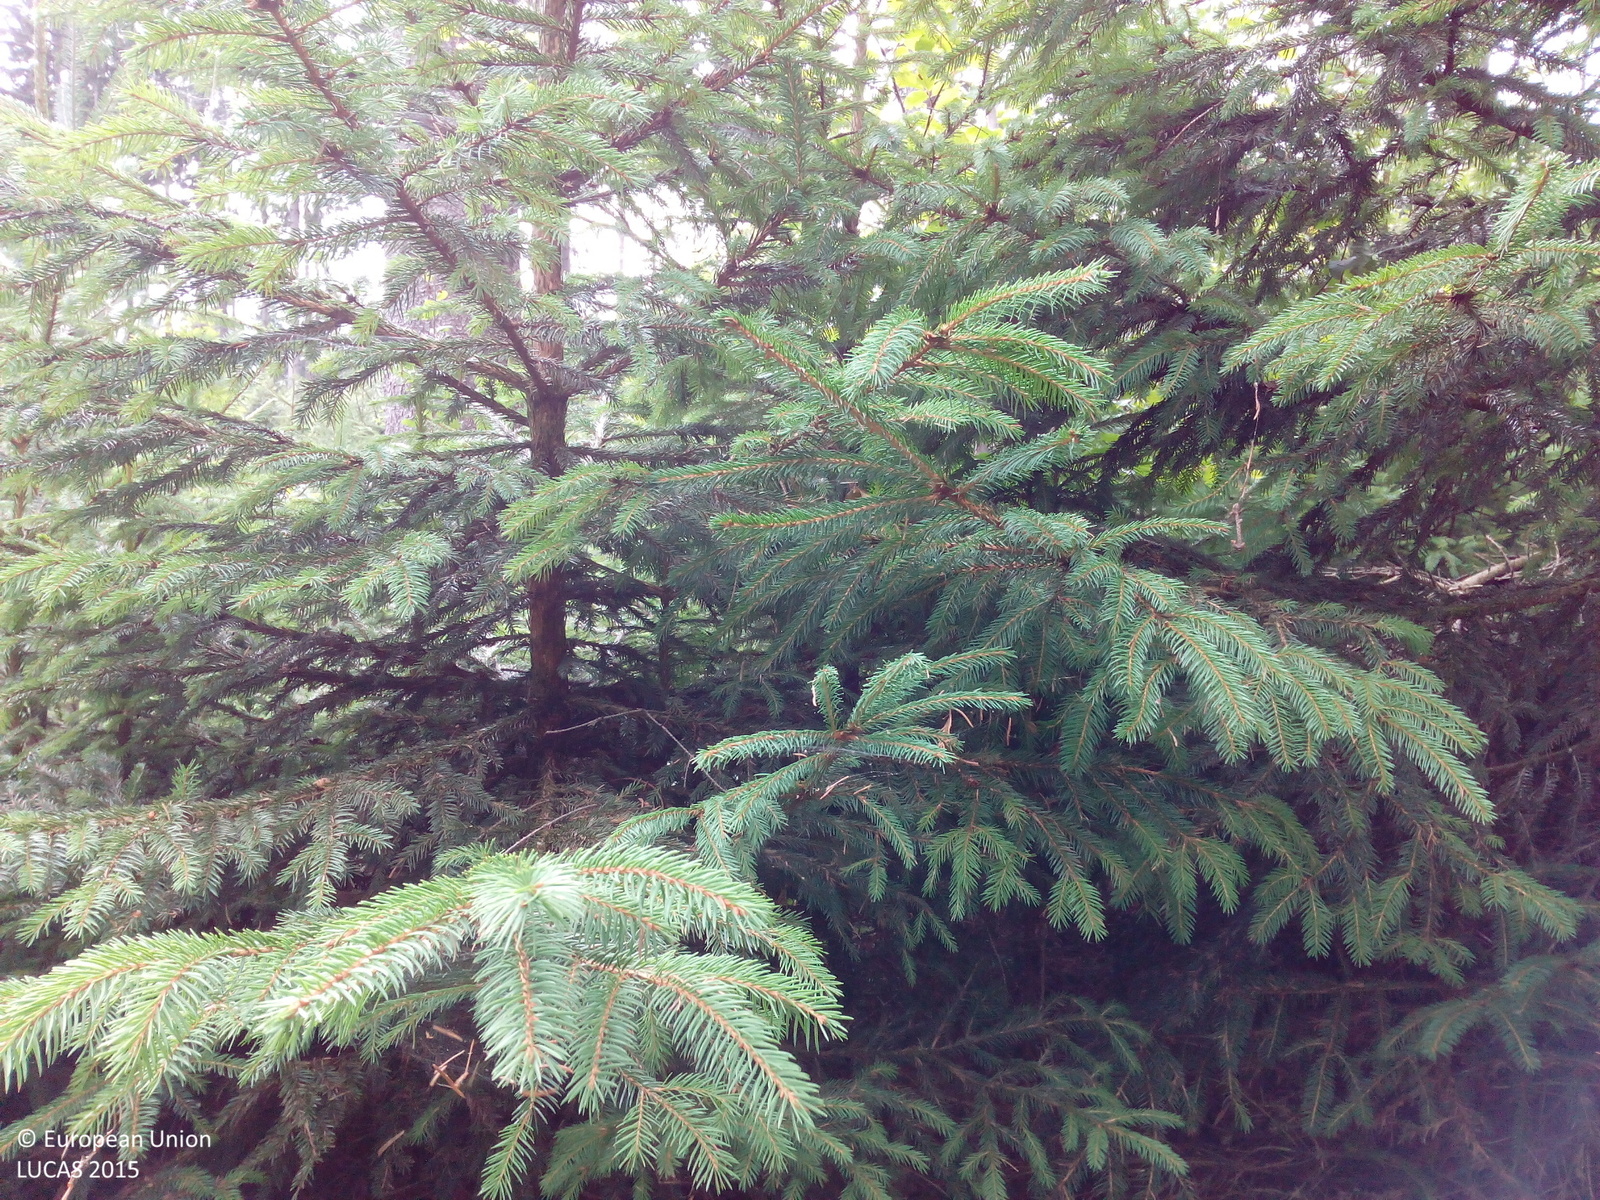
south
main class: Woodland
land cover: Spruce dominated coniferous woodland
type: hemiboreal forest and nemoral coniferous forest and mixed broadleaved-coniferous forest
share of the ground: > 75 %
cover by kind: coniferous forest trees 90 %
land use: Forestry
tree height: < 5 m
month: August
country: DE
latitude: 50.3890
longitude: 11.5890
